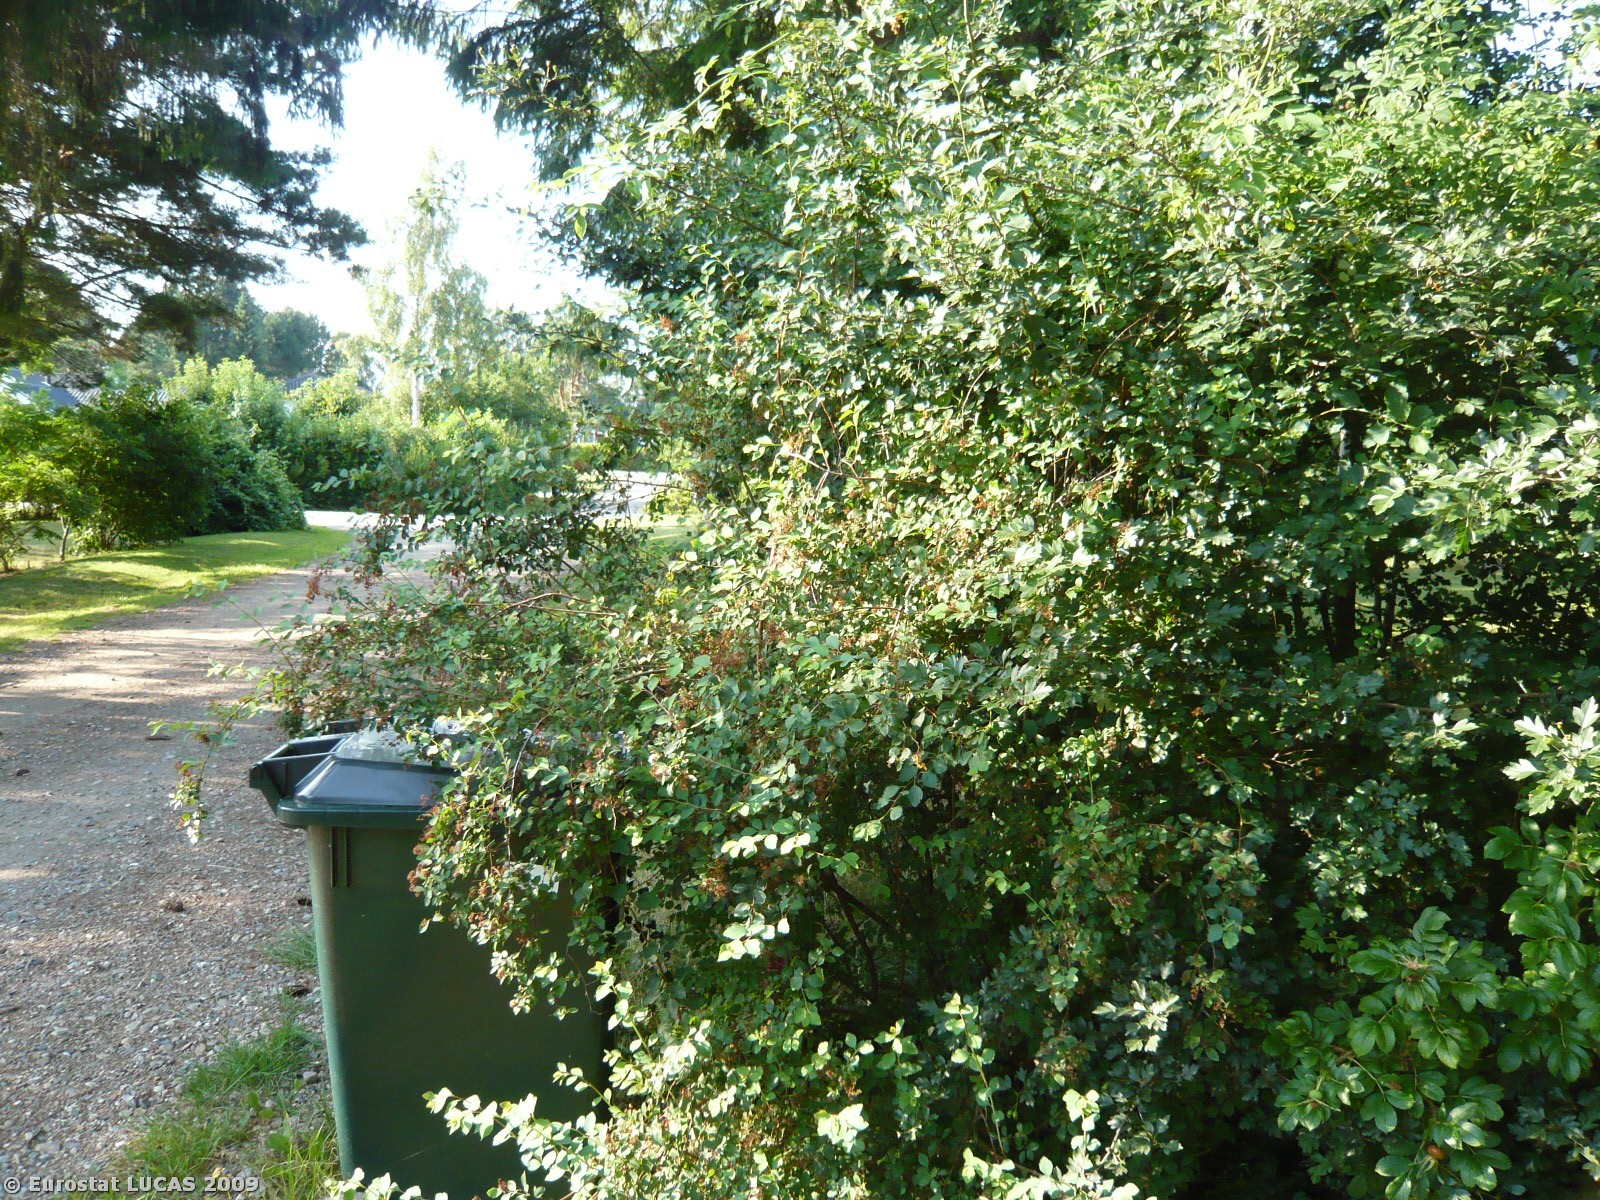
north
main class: Woodland
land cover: Coniferous woodland
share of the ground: > 75 %
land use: Holiday camps
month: July
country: DK
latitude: 55.7997
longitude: 11.6415
